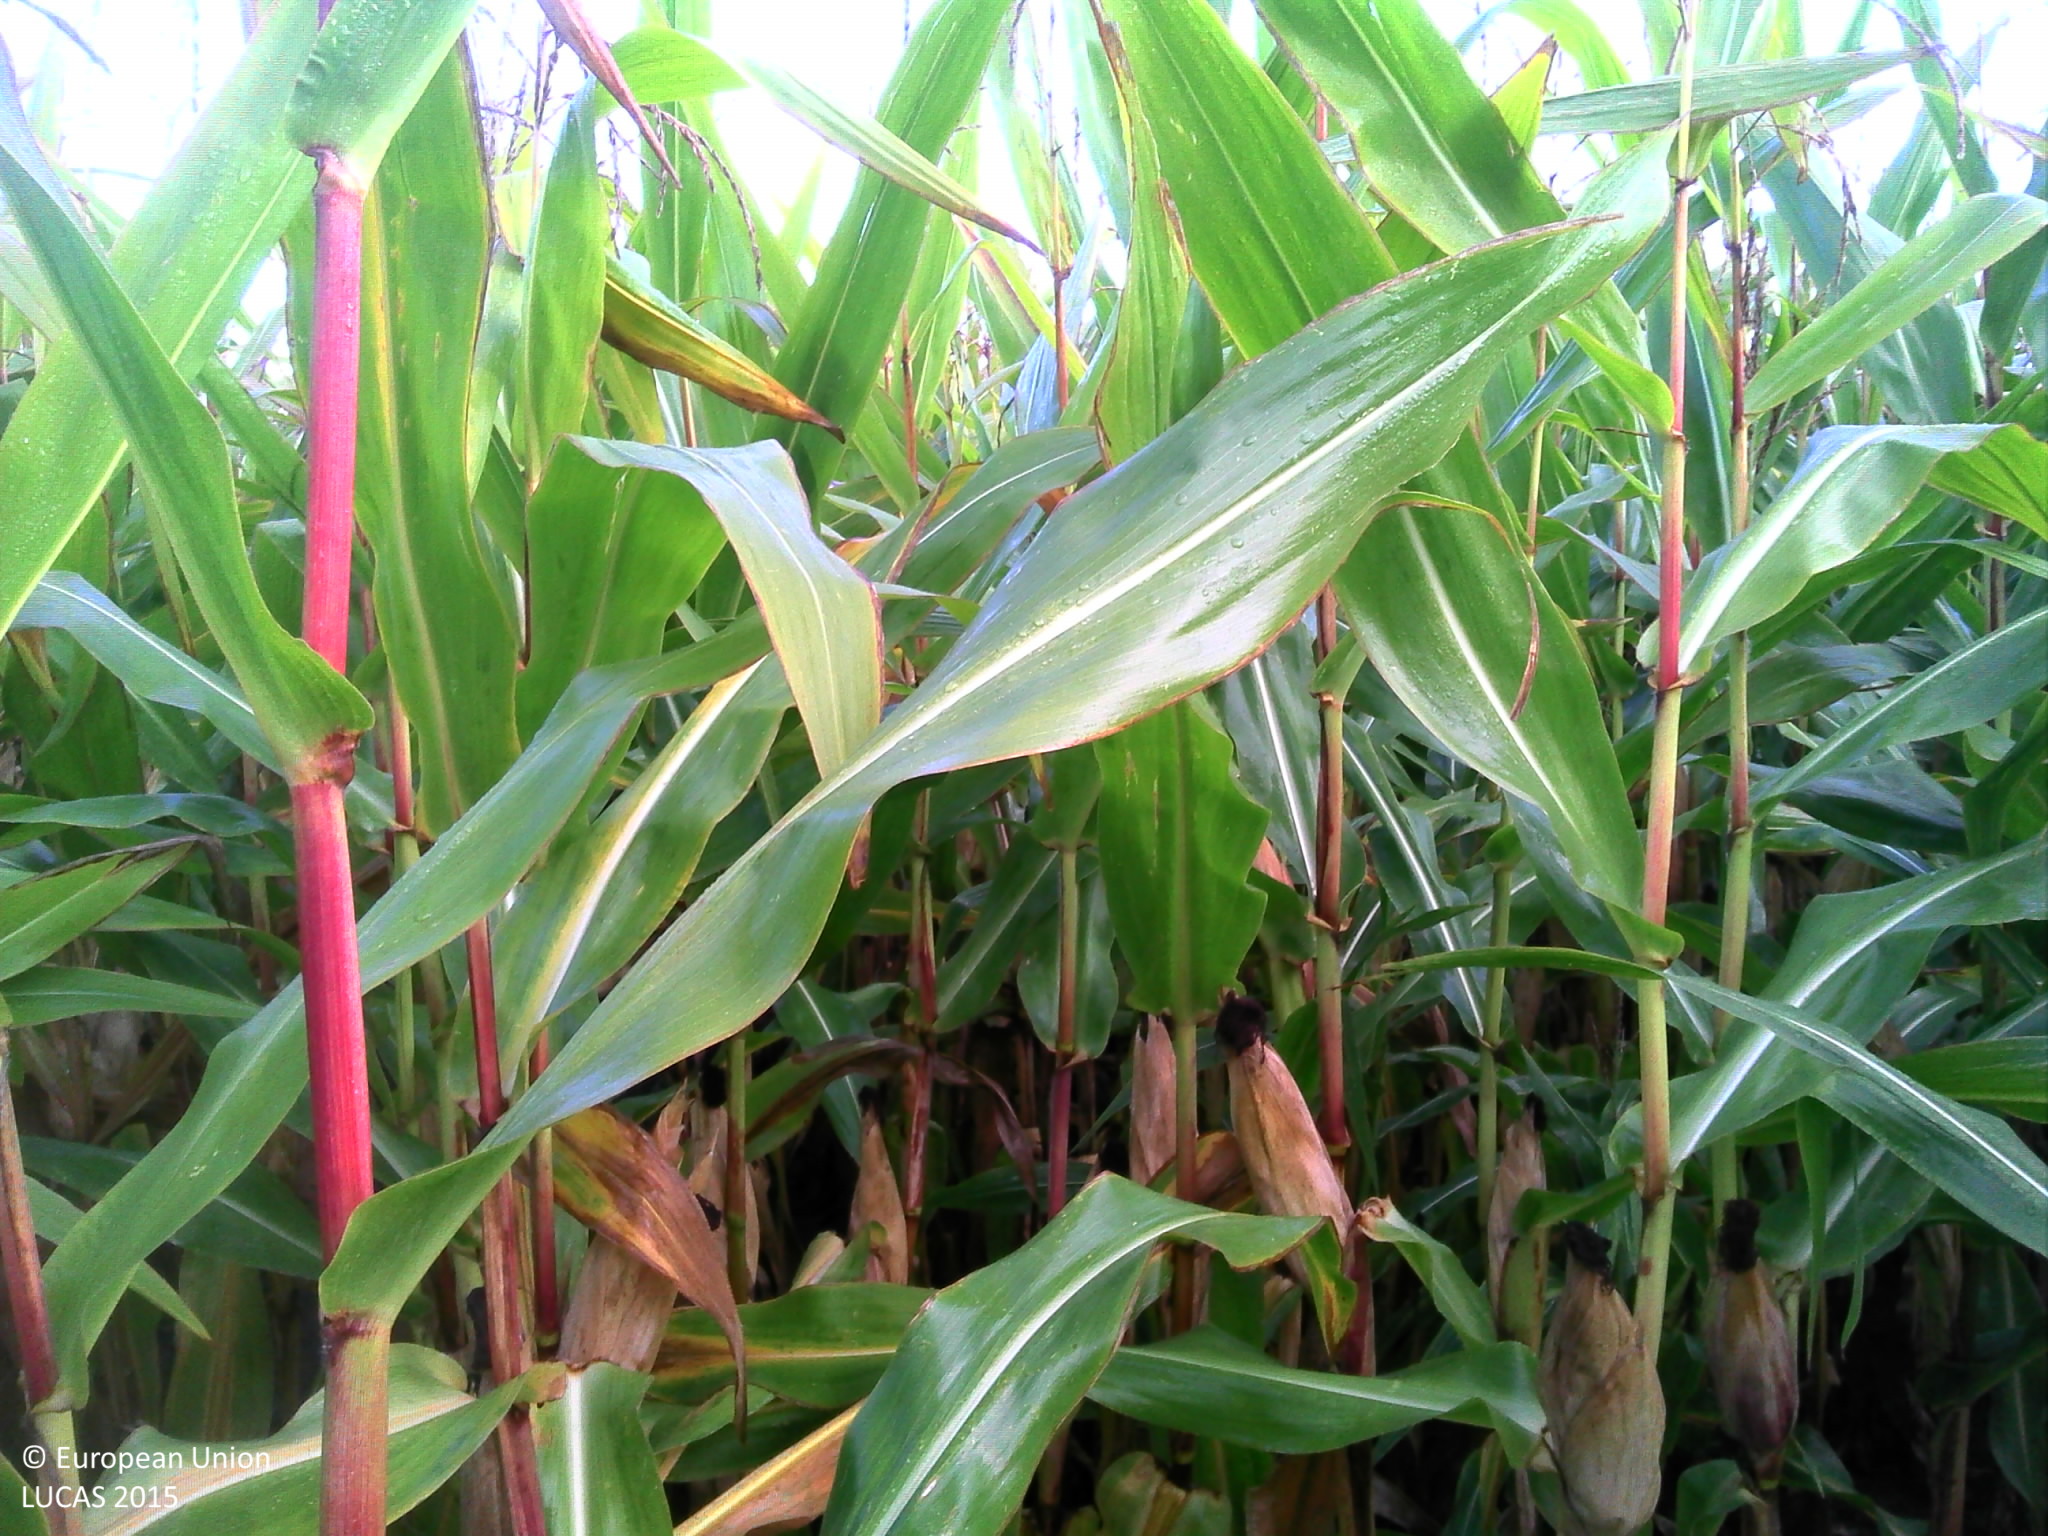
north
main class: Cropland
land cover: Maize
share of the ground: > 75 %
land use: Agriculture (excluding fallow land and kitchen gardens)
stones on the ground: < 10 %
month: September
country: BE
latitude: 51.0747
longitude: 4.4149
